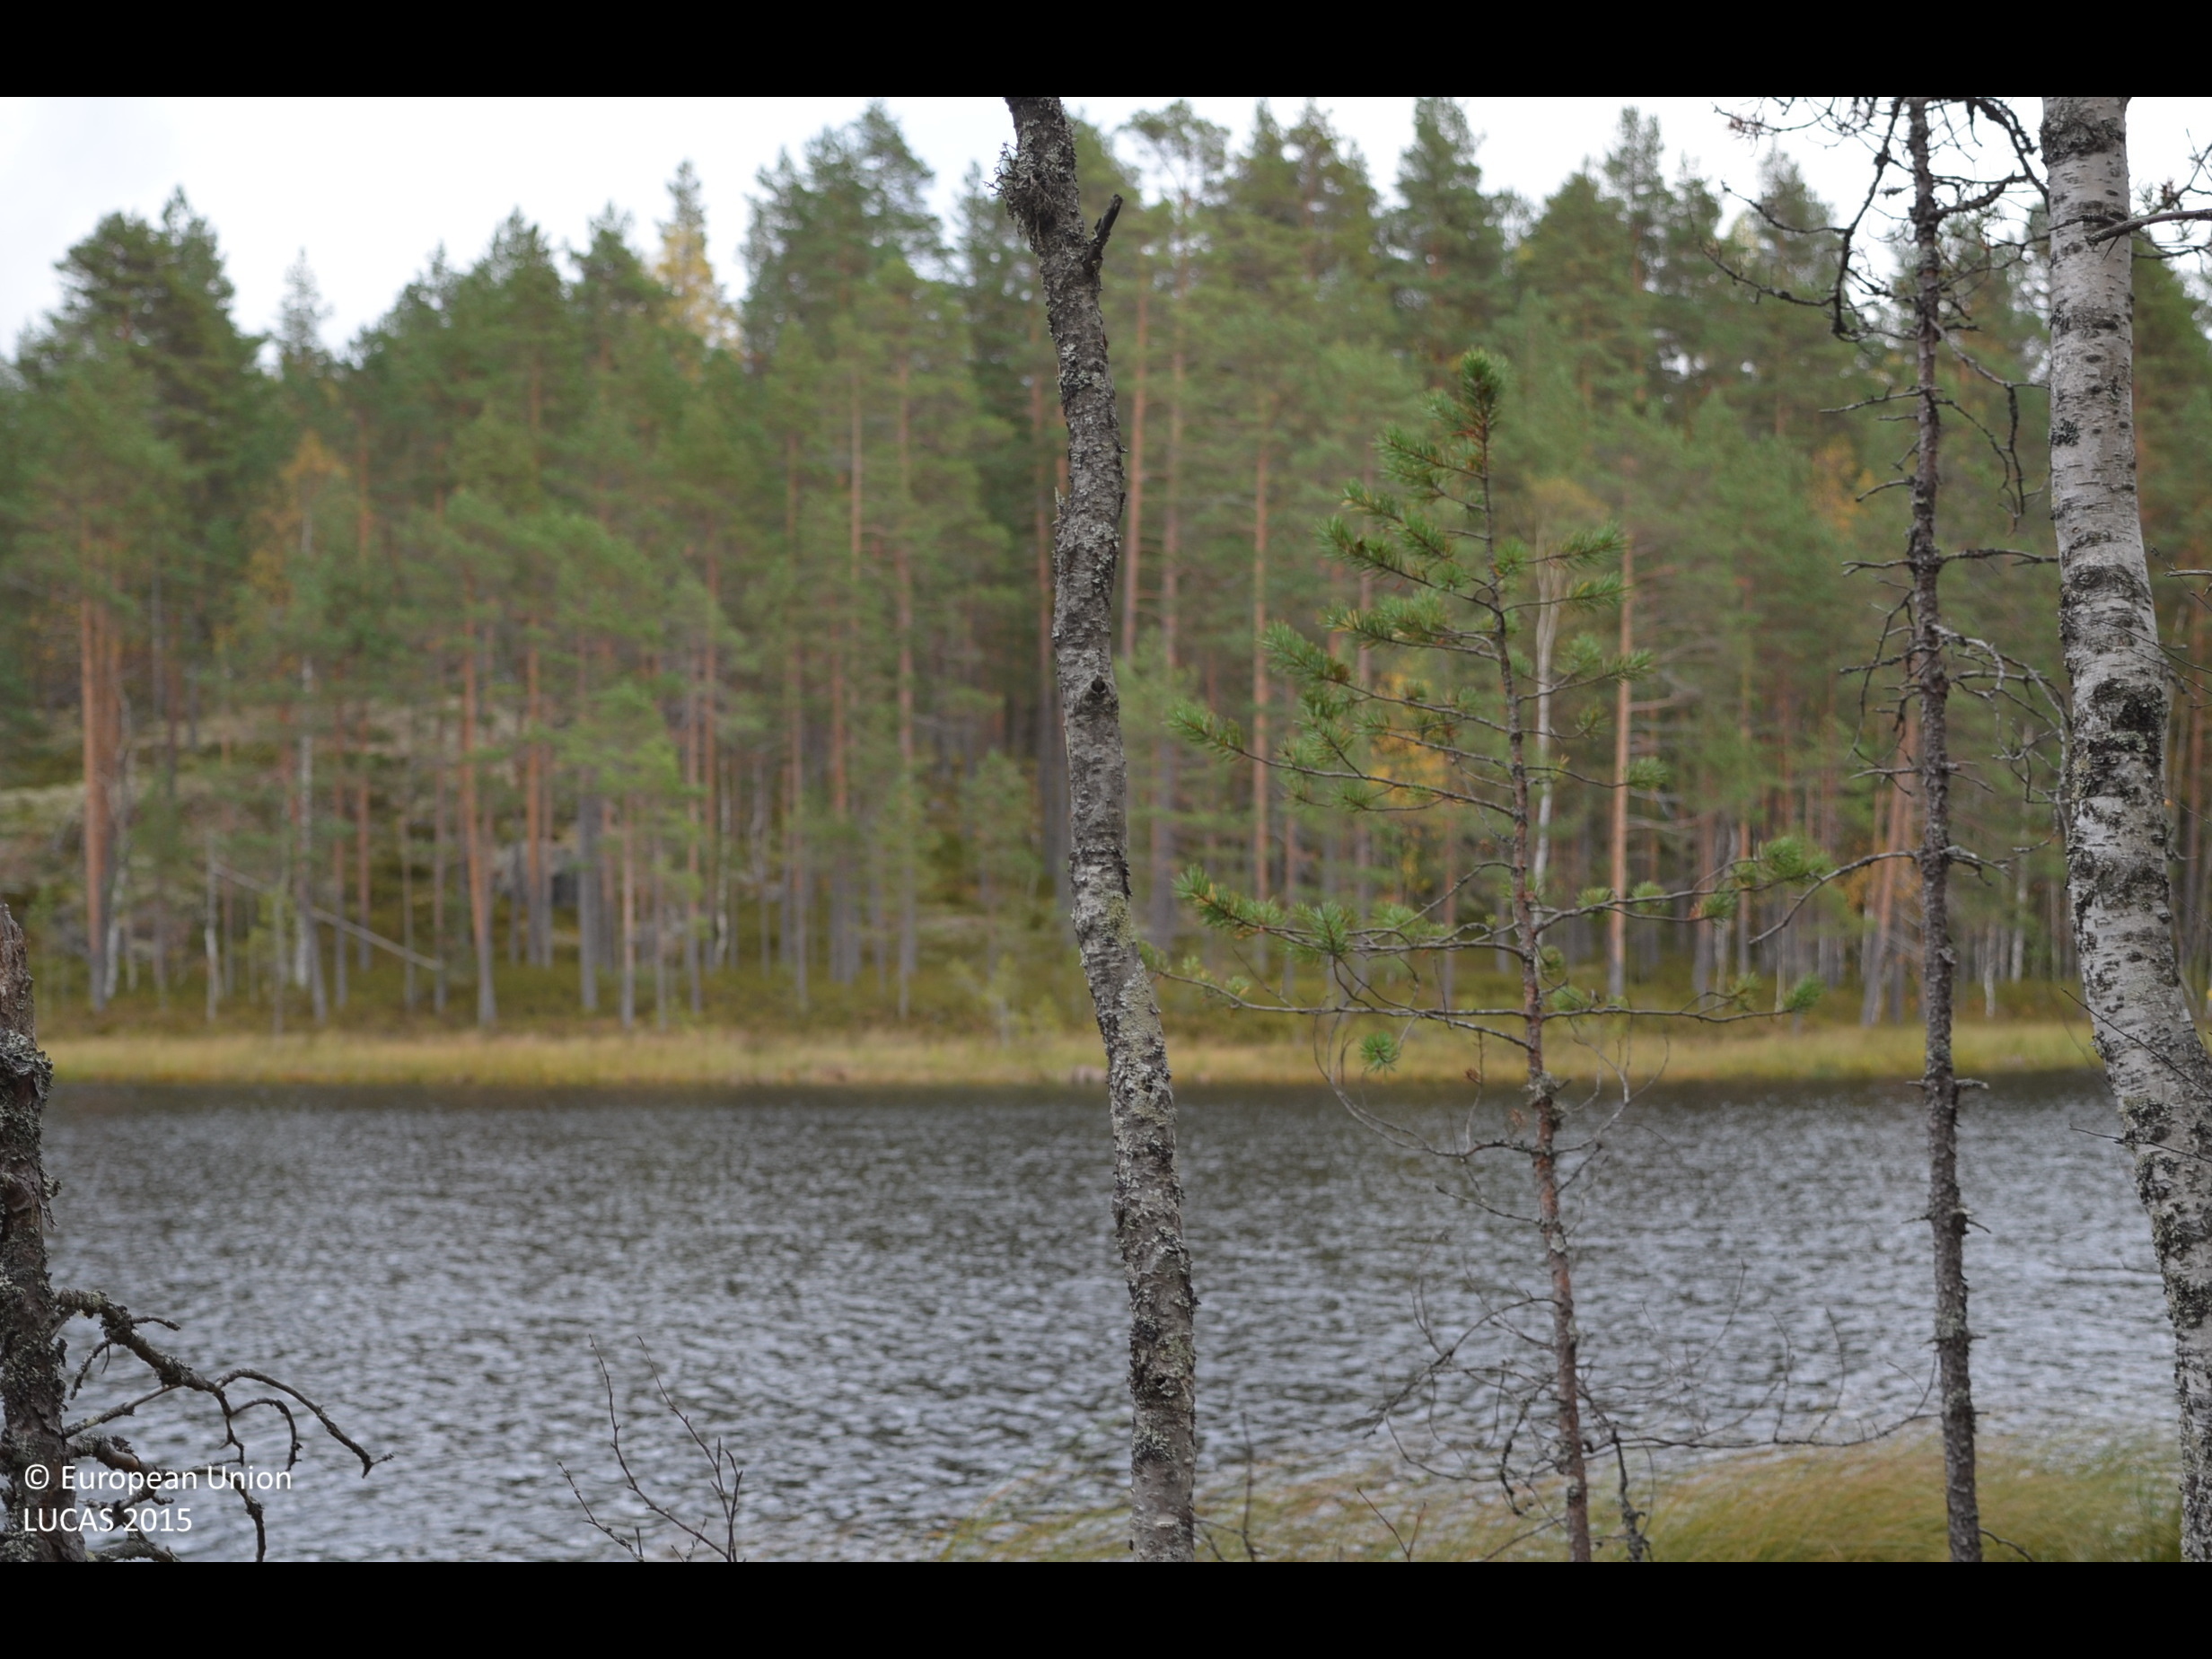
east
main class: Woodland
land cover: Pine dominated mixed woodland
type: boreal forest
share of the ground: 50 - 75 %
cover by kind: coniferous forest trees 50 %, shrubs 25 %, broadleaved forest trees 20 %, lichens and mosses 5 %
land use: Forestry
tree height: > 5 m
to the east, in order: Pine dominated mixed woodland; Inland marshes; Inland fresh water bodies; Inland marshes; Pine dominated mixed woodland; Pine dominated coniferous woodland
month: September
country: FI
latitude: 62.4308
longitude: 23.6116
